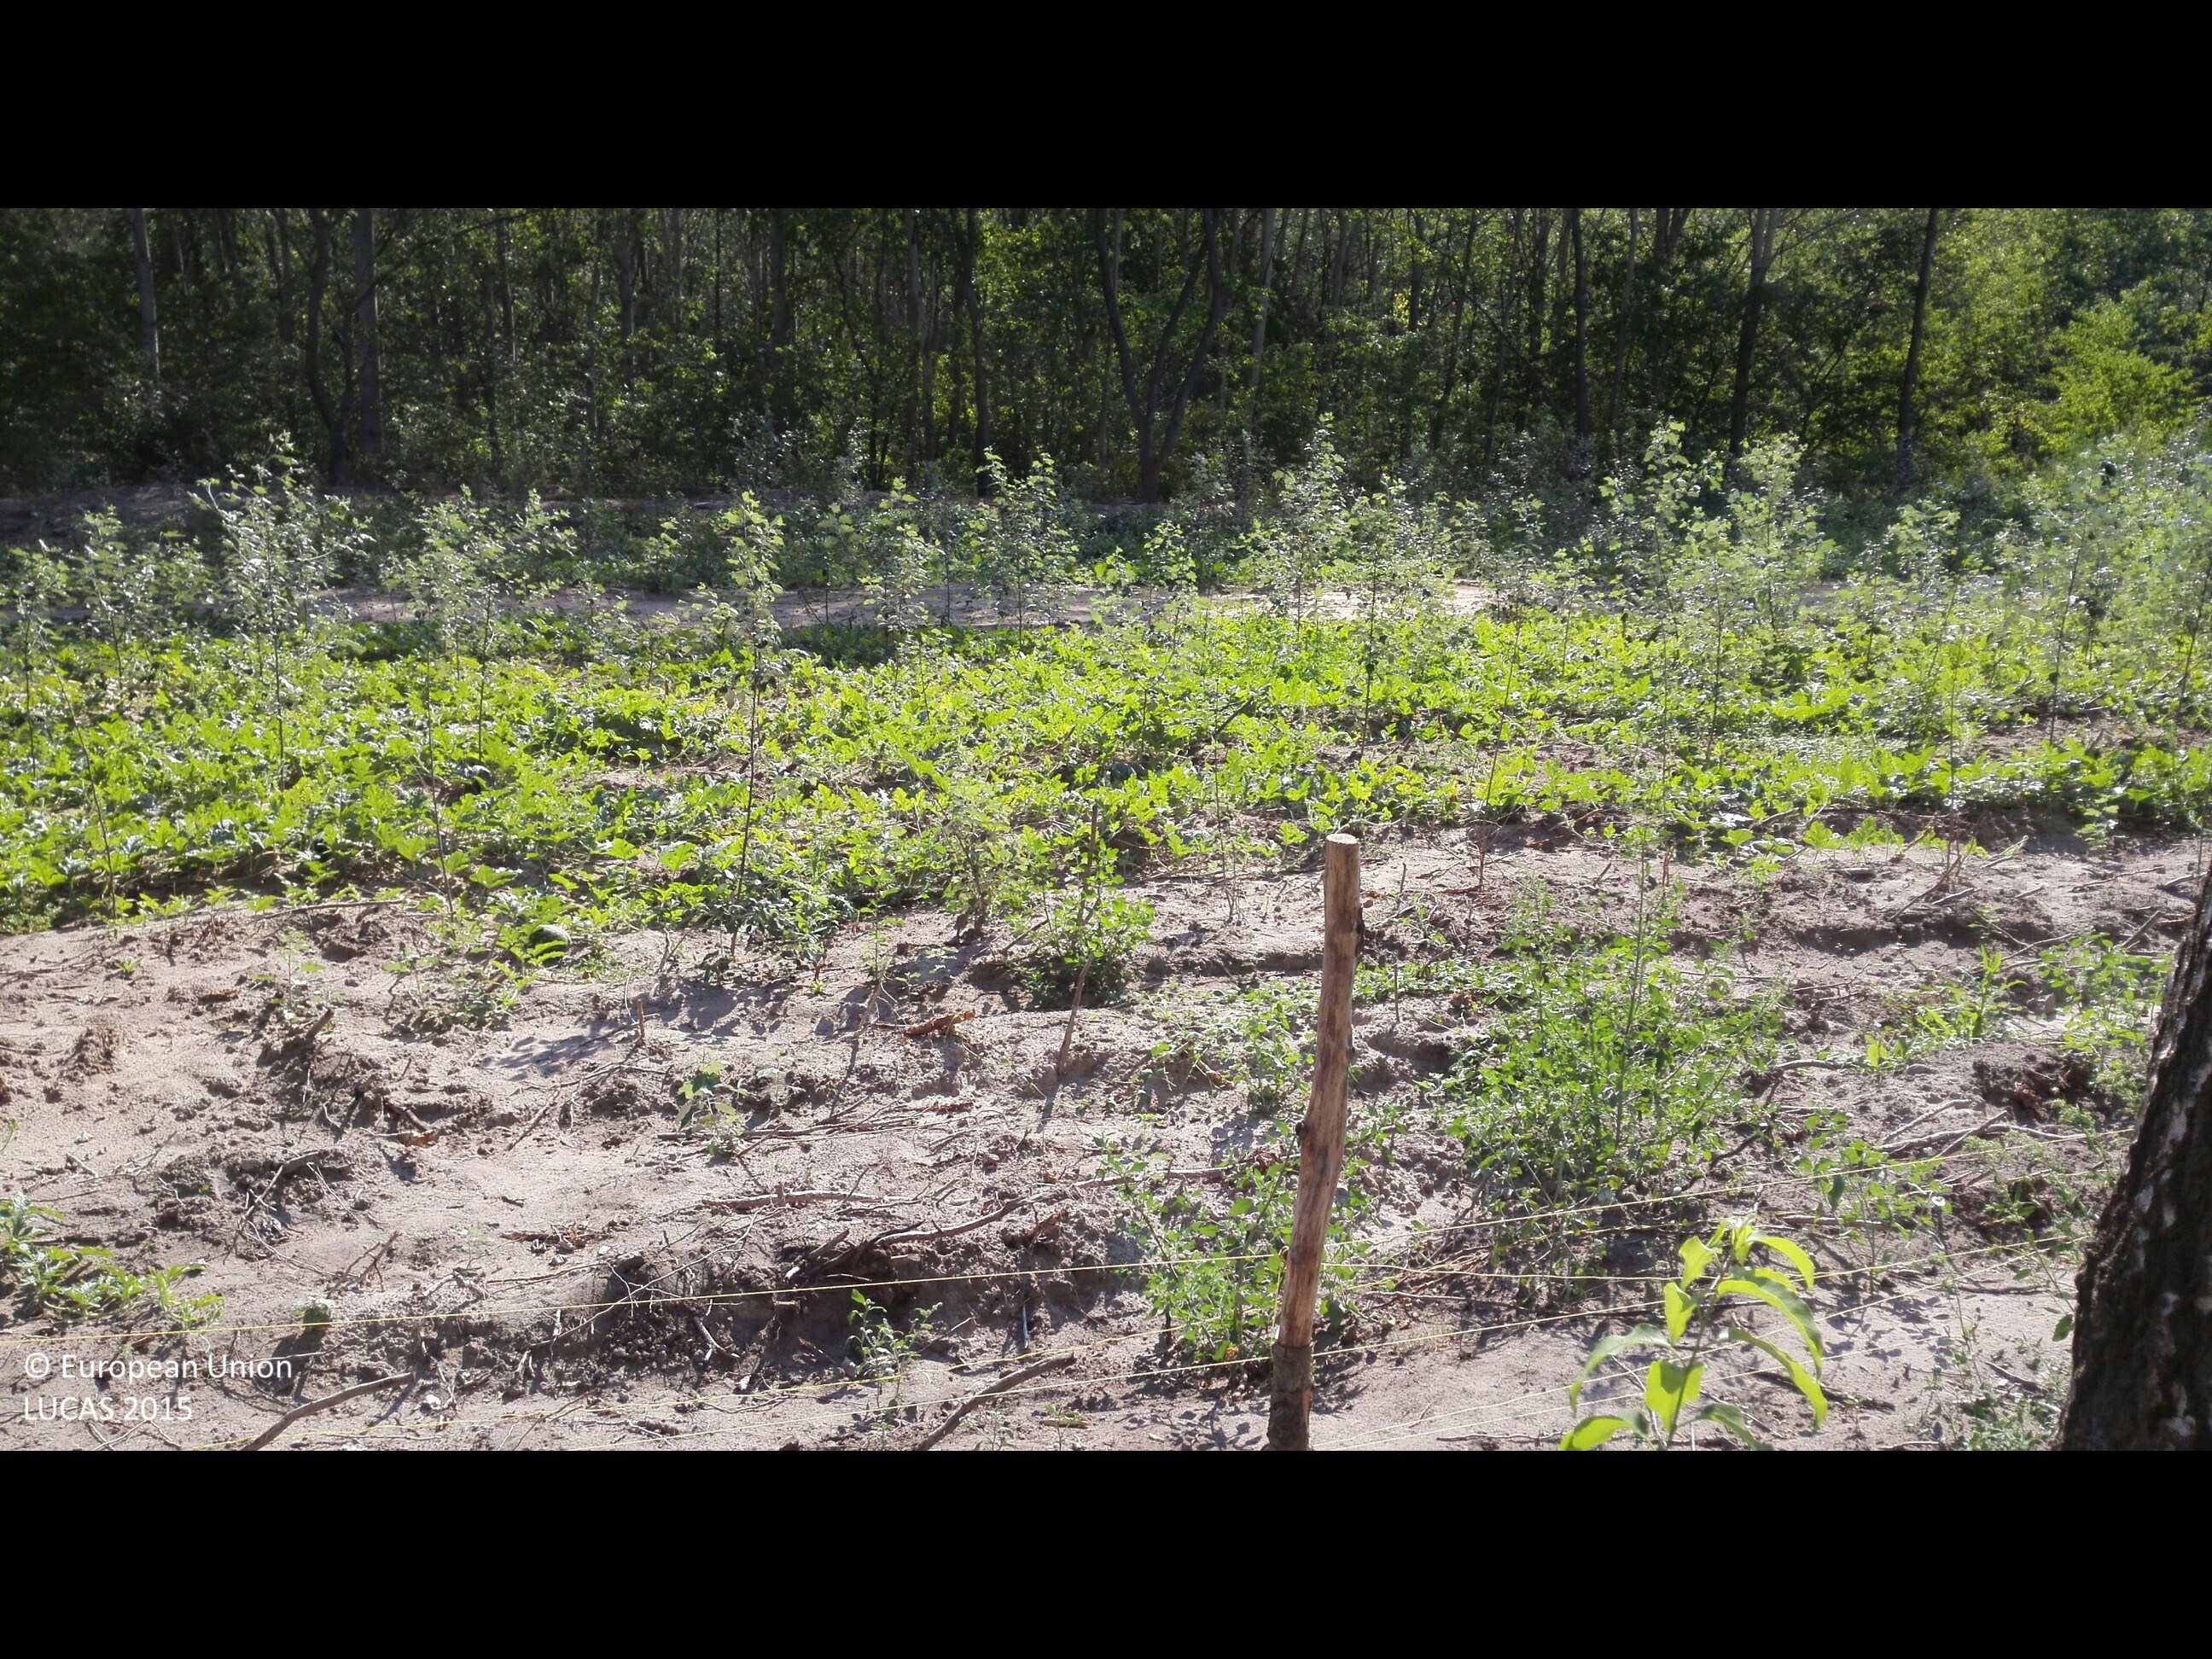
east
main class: Woodland
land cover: Broadleaved woodland
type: non-riverine alder, birch or aspen forest
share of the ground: > 75 %
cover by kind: broadleaved forest trees 80 %, herbaceous plants 15 %, shrubs 5 %
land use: Forestry
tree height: > 5 m
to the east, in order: Broadleaved woodland; Fences; Broadleaved woodland; Fences; Broadleaved woodland; Pine dominated mixed woodland
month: August
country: HU
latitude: 47.5055
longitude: 21.7158
